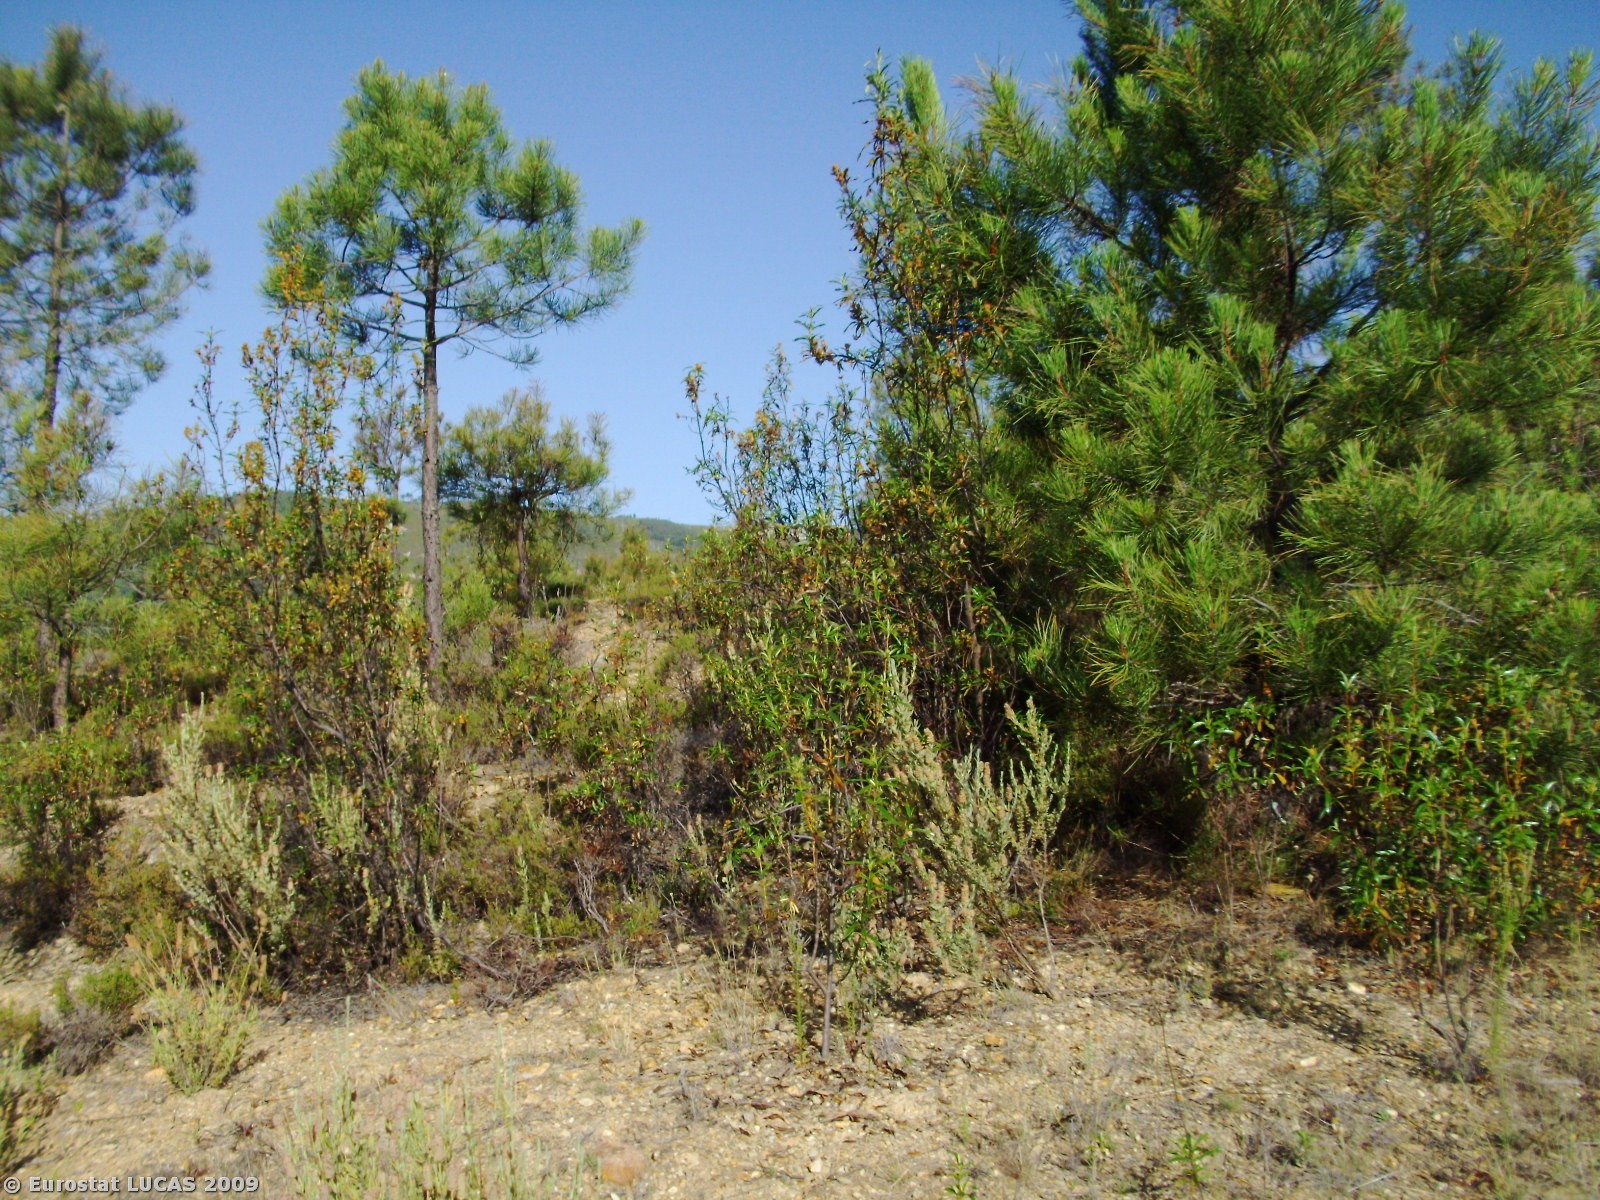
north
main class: Woodland
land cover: Coniferous woodland
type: coniferous forest of the mediterranean region
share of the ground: 25 - 50 %
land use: Forestry
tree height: > 5 m
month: June
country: PT
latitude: 39.9806
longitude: -7.6592
